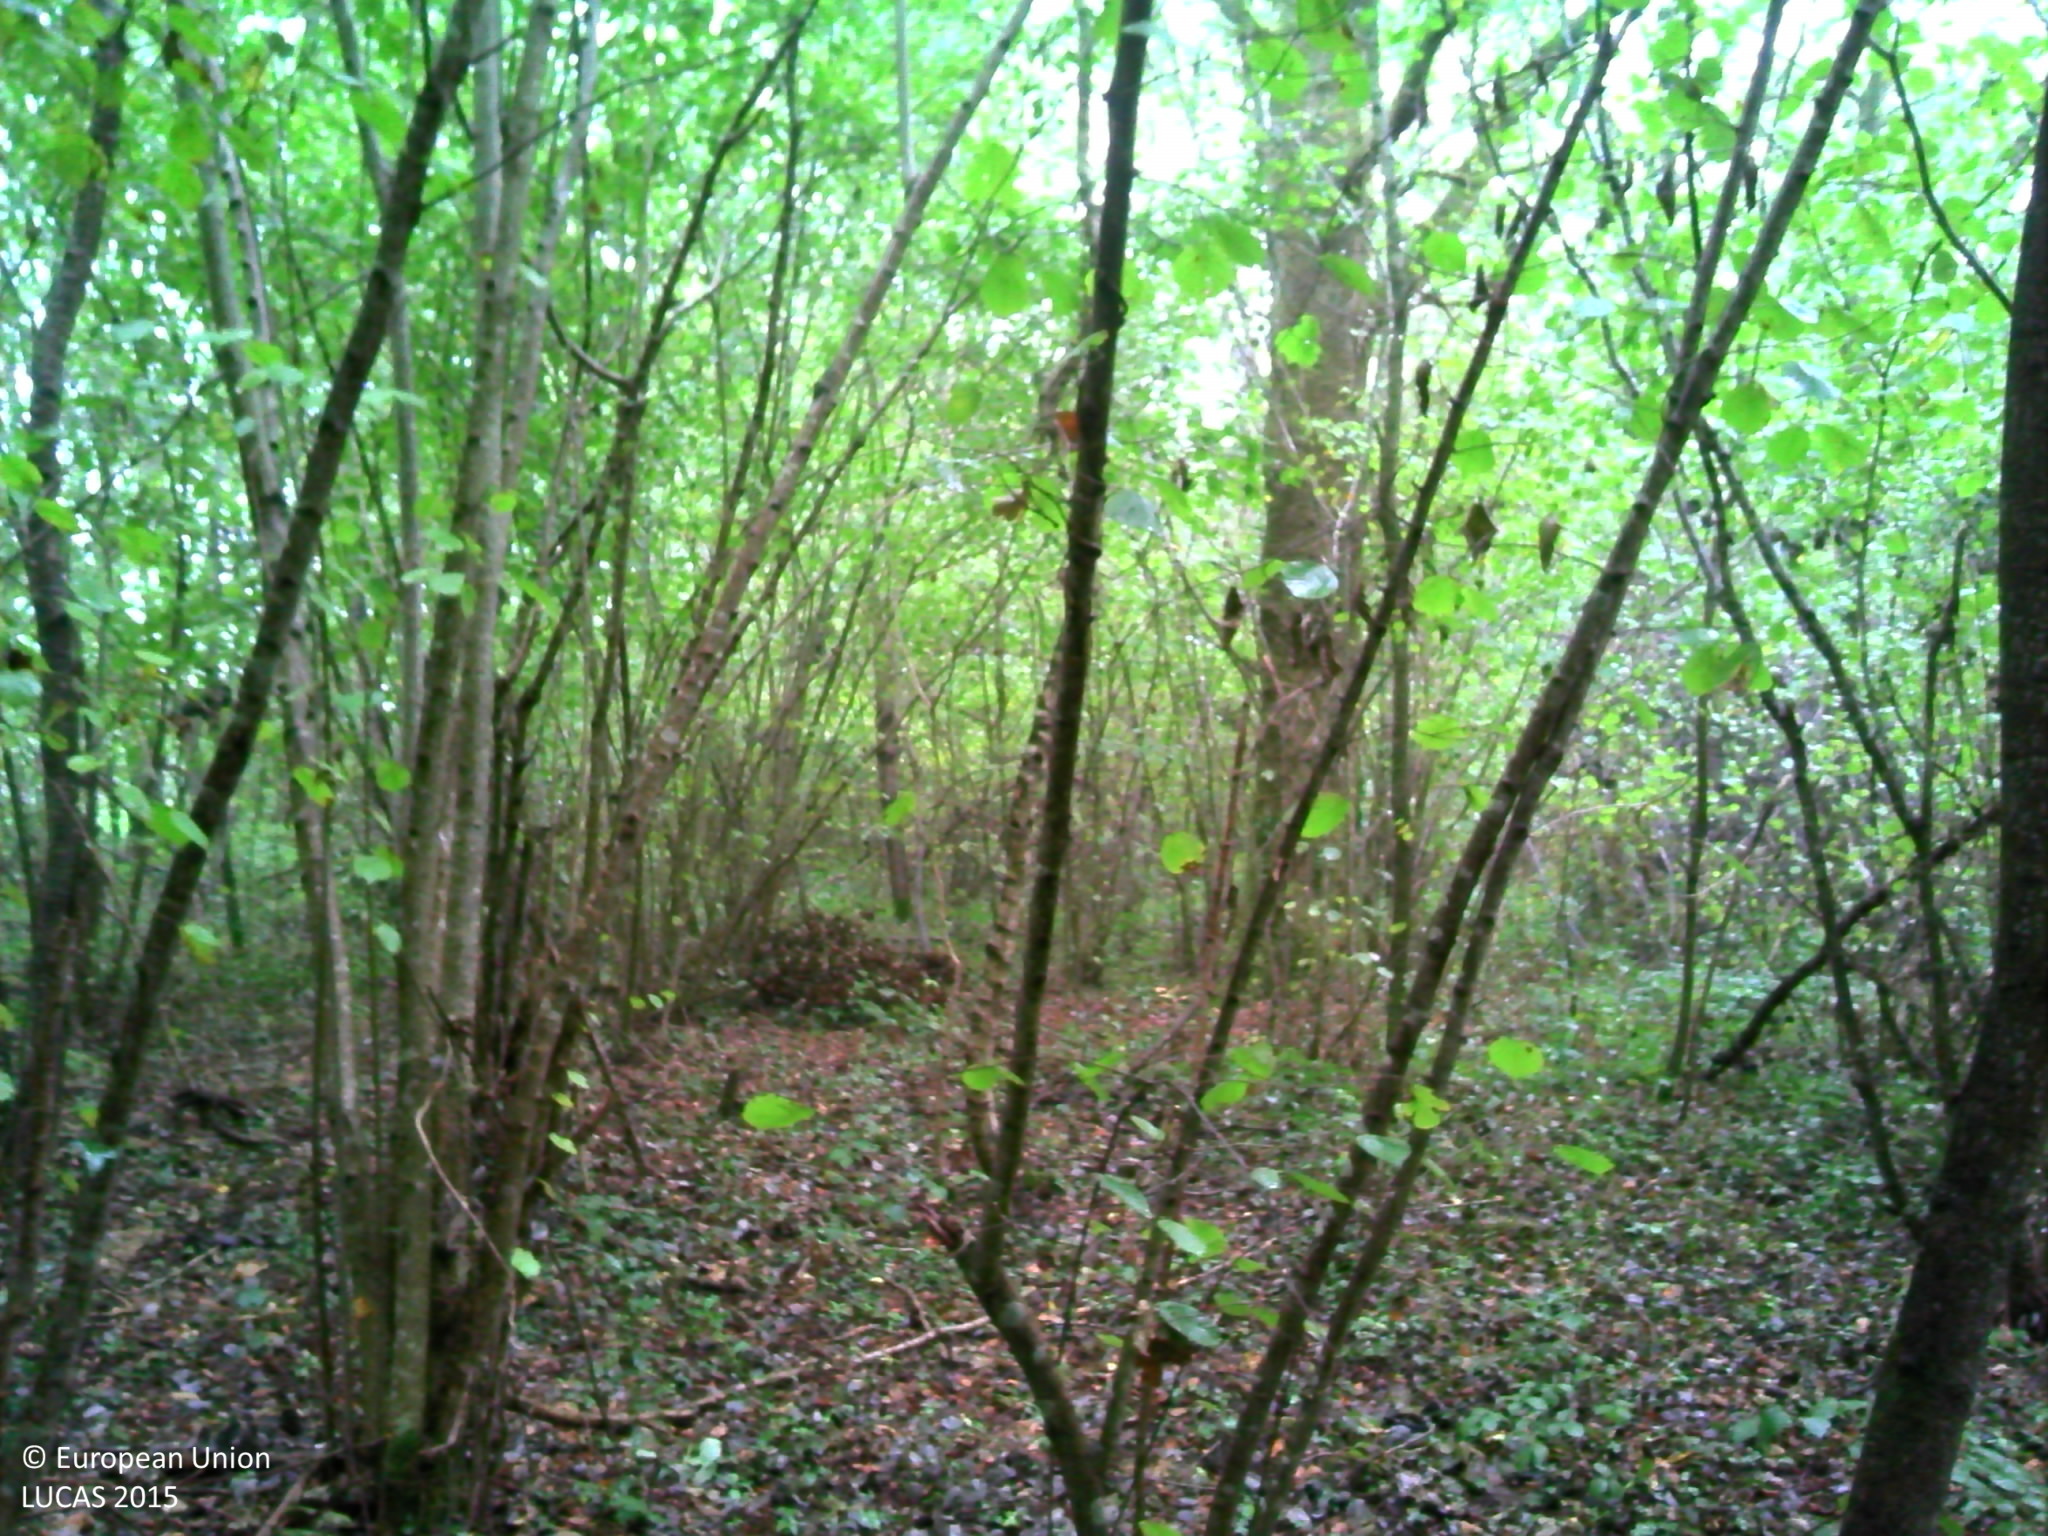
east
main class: Woodland
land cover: Broadleaved woodland
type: mesophytic deciduous forest
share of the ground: > 75 %
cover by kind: broadleaved forest trees 90 %, herbaceous plants 5 %, lichens and mosses 5 %
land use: Forestry
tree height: > 5 m
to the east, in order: Broadleaved woodland; Ditches and canals; Tracks; Ditches and canals; Fences; Grassland without tree/shrub cover; Fences; Grassland without tree/shrub cover
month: October
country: FR
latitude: 46.4204
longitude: 5.1232
